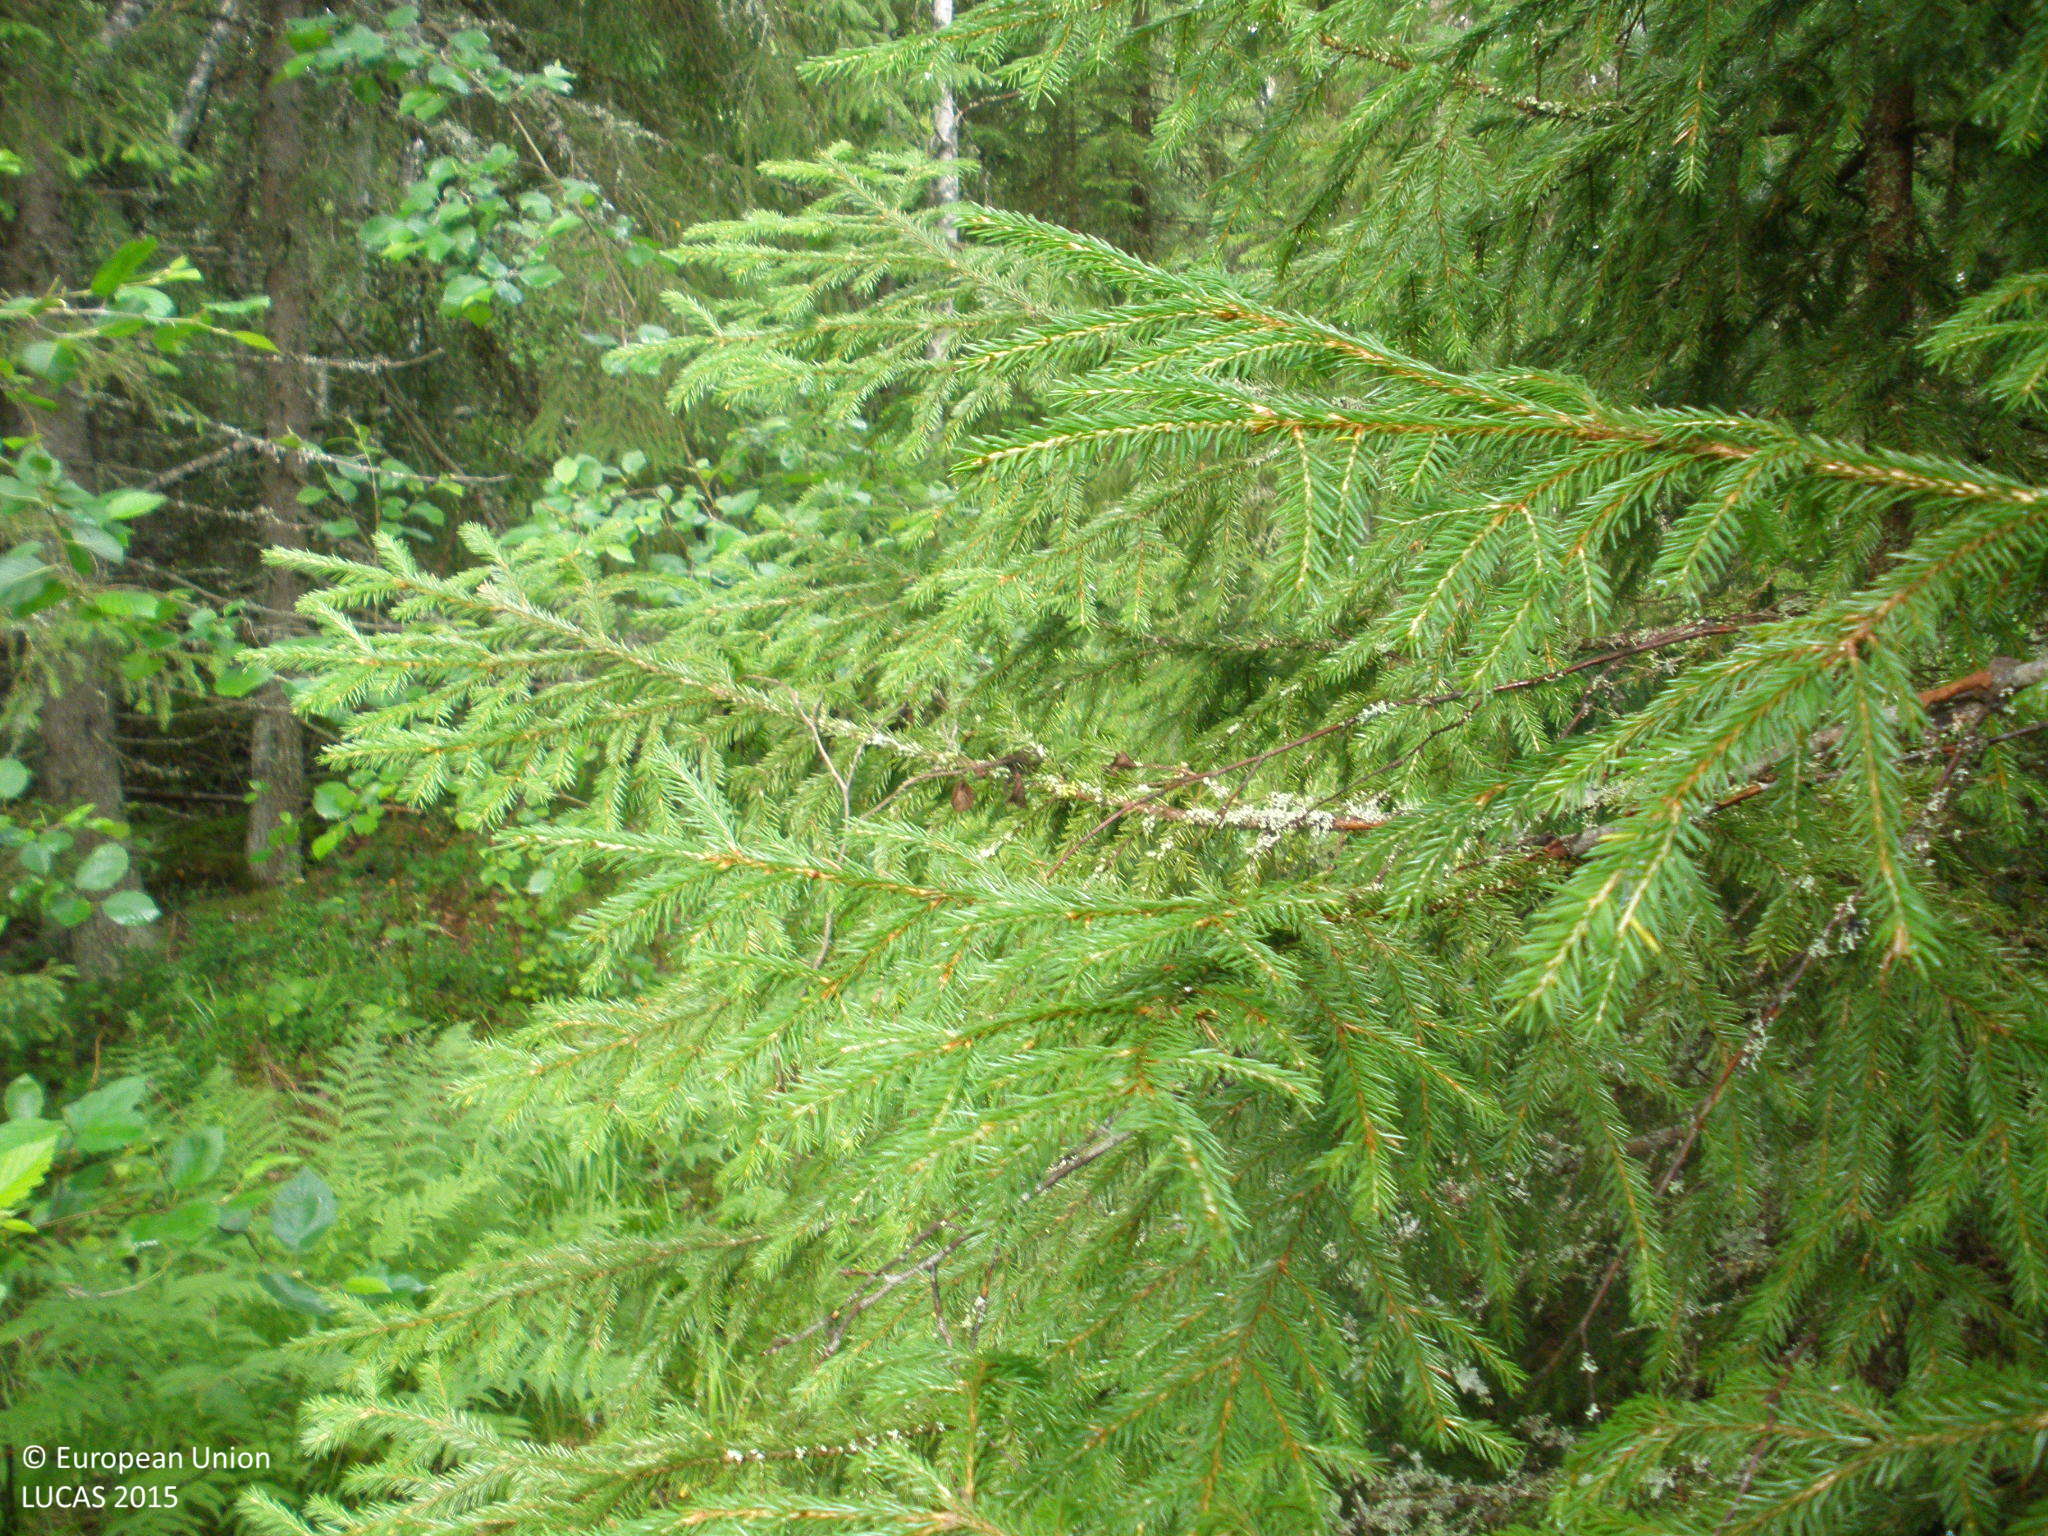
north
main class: Woodland
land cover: Spruce dominated mixed woodland
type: boreal forest
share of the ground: > 75 %
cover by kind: coniferous forest trees 60 %, broadleaved forest trees 25 %, herbaceous plants 10 %, lichens and mosses 5 %
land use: Forestry
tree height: > 5 m
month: July
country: FI
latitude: 61.3323
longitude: 24.8892
